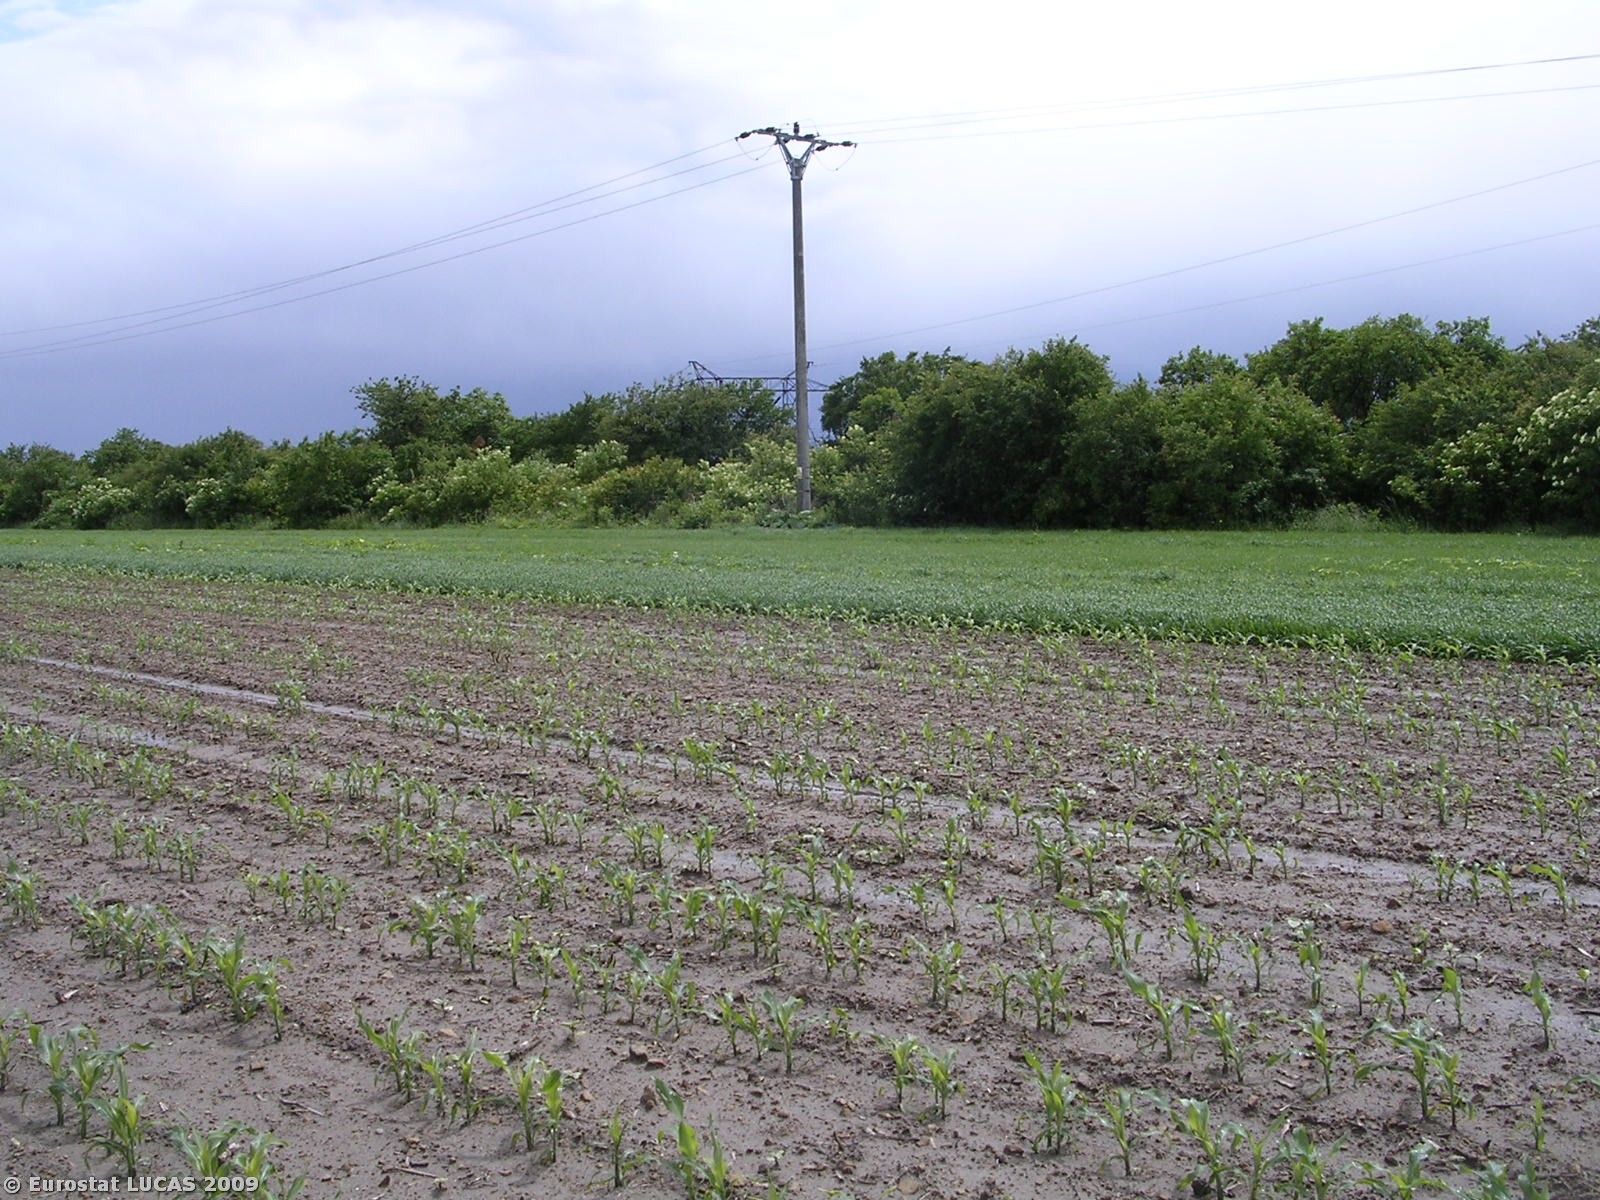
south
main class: Cropland
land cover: Maize
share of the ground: 10 - 25 %
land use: Agriculture (excluding fallow land and kitchen gardens)
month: May
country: CZ
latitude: 50.4222
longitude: 14.4353
